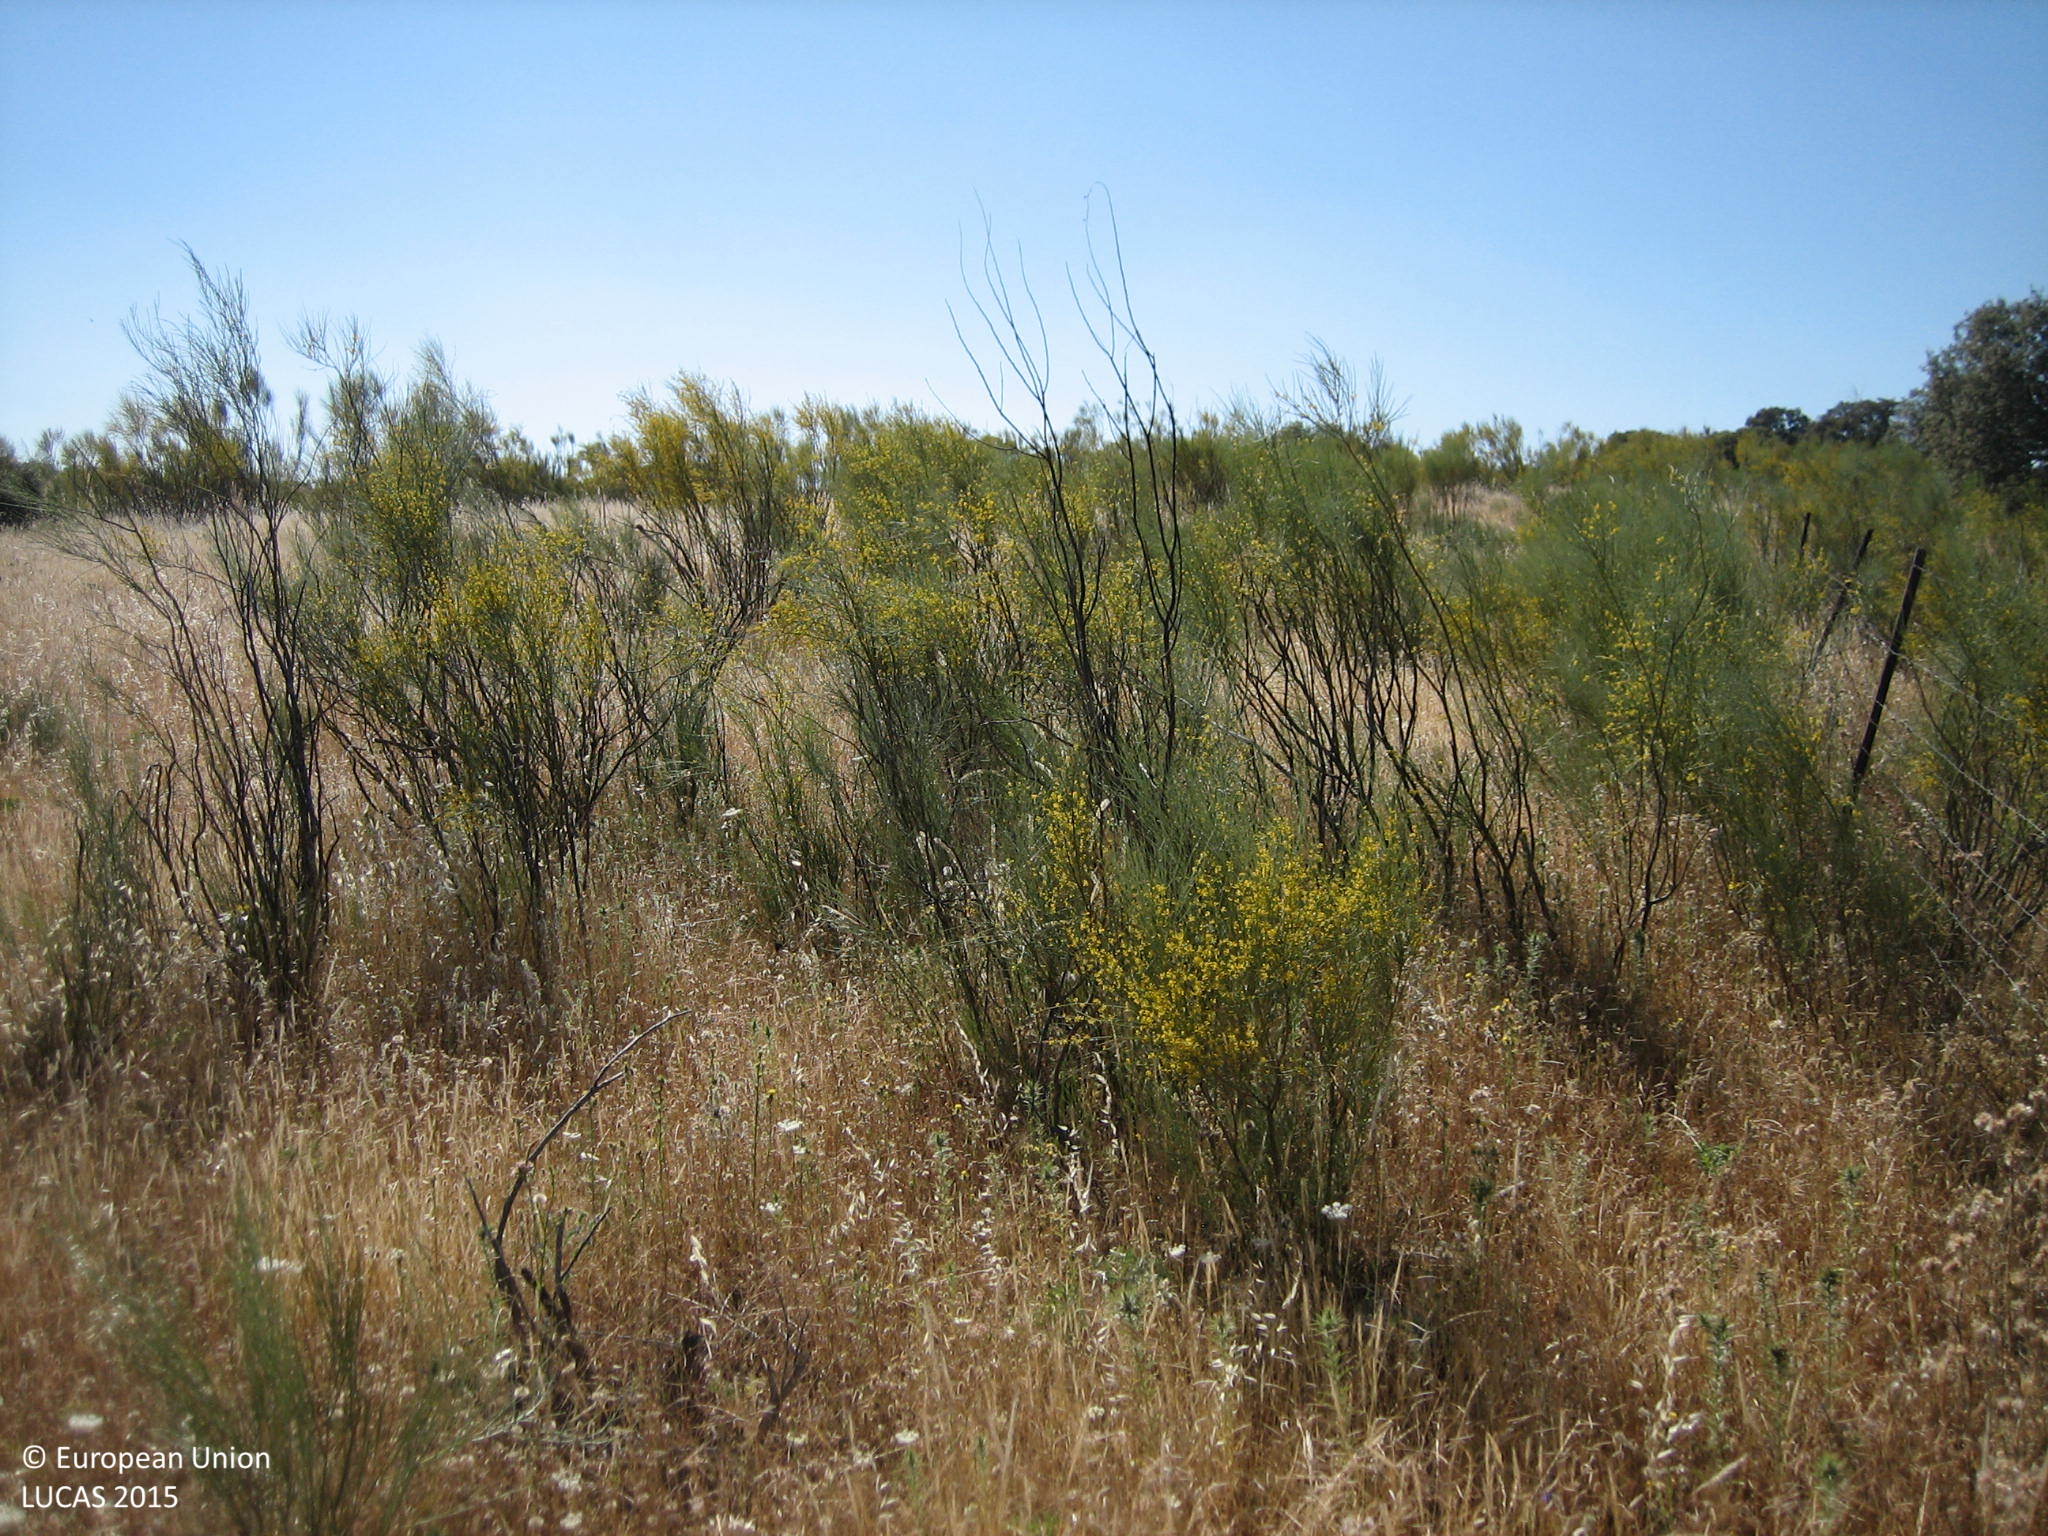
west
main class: Grassland
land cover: Grassland with sparse tree/shrub cover
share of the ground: > 75 %
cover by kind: herbaceous plants 90 %, broadleaved forest trees 5 %, shrubs 5 %
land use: Agriculture (excluding fallow land and kitchen gardens)
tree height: > 5 m
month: May
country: ES
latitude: 38.5459
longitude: -3.9780
